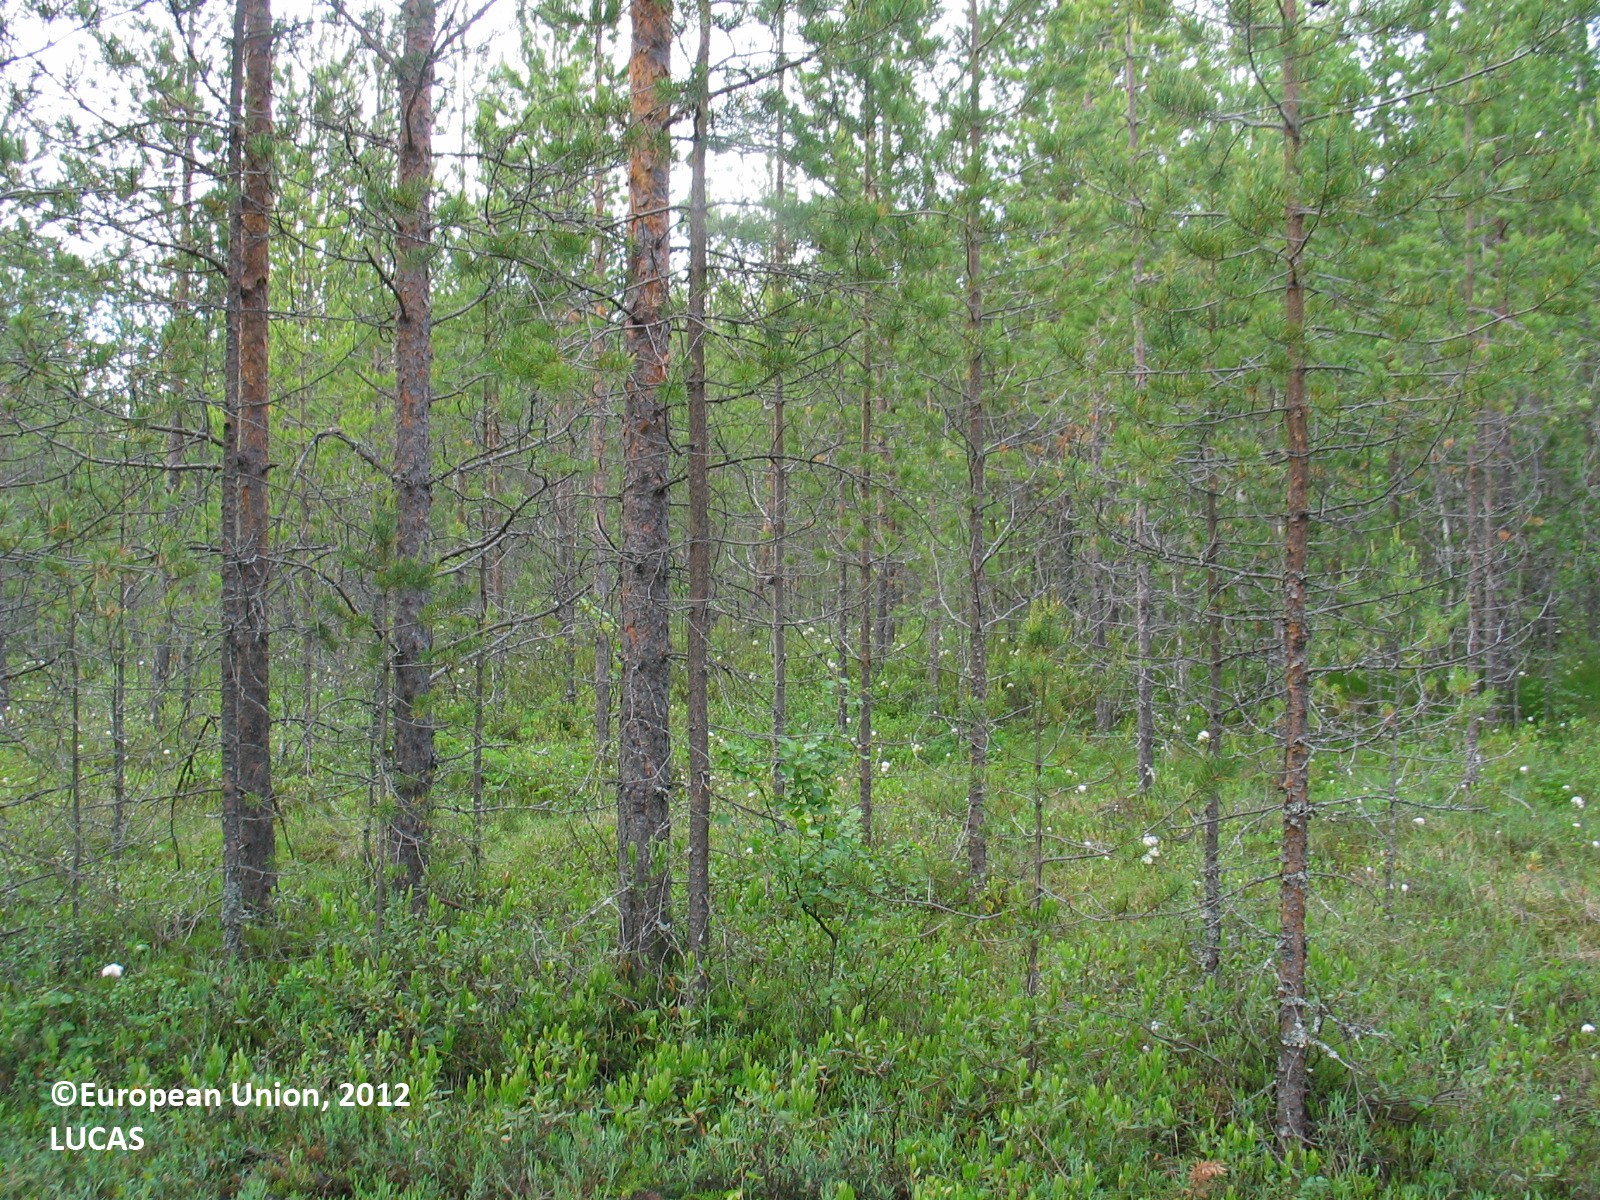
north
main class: Woodland
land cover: Pine dominated coniferous woodland
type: mire and swamp forests
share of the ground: 25 - 50 %
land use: Forestry
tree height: > 5 m
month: June
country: FI
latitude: 64.8725
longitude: 26.2062
